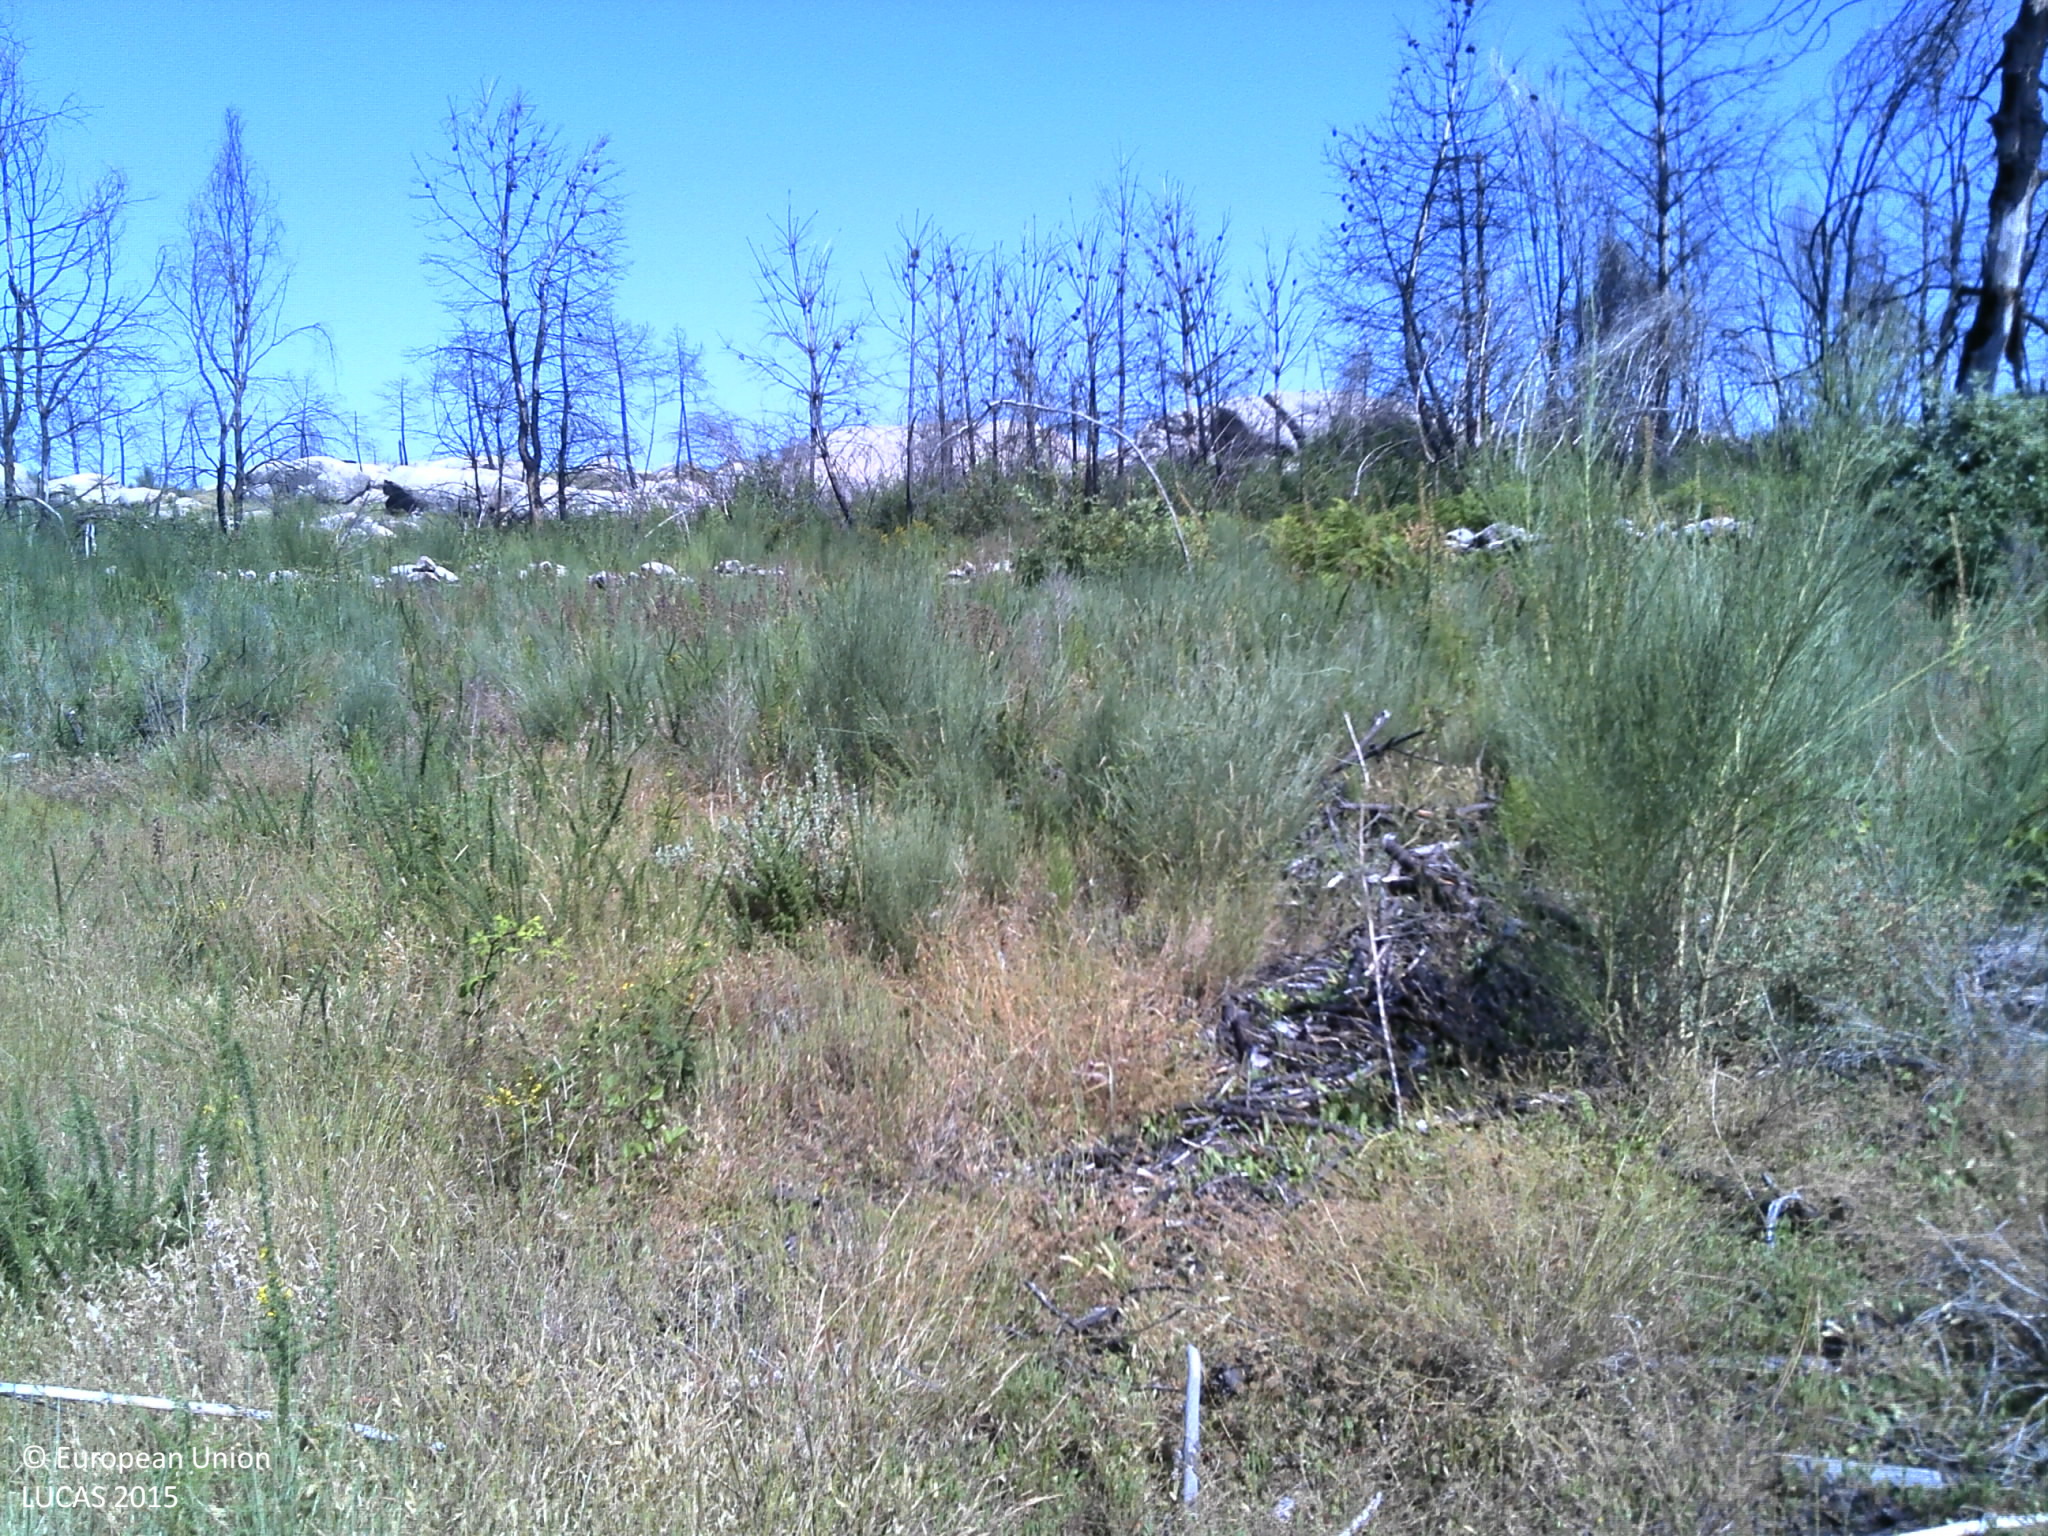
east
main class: Shrubland
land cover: Shrubland without tree cover
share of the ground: > 75 %
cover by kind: shrubs 90 %, herbaceous plants 10 %
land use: Abandoned areas
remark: Burnt area
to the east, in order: Shrubland without tree cover; Dry stone walls; Shrubland with sparse tree cover; Dry stone walls; Spontaneously vegetated surfaces; Rocks and stones; Spontaneously vegetated surfaces; Rocks and stones; Spontaneously vegetated surfaces; Tracks; Shrubland with sparse tree cover
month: July
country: PT
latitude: 40.7670
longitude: -7.4947
